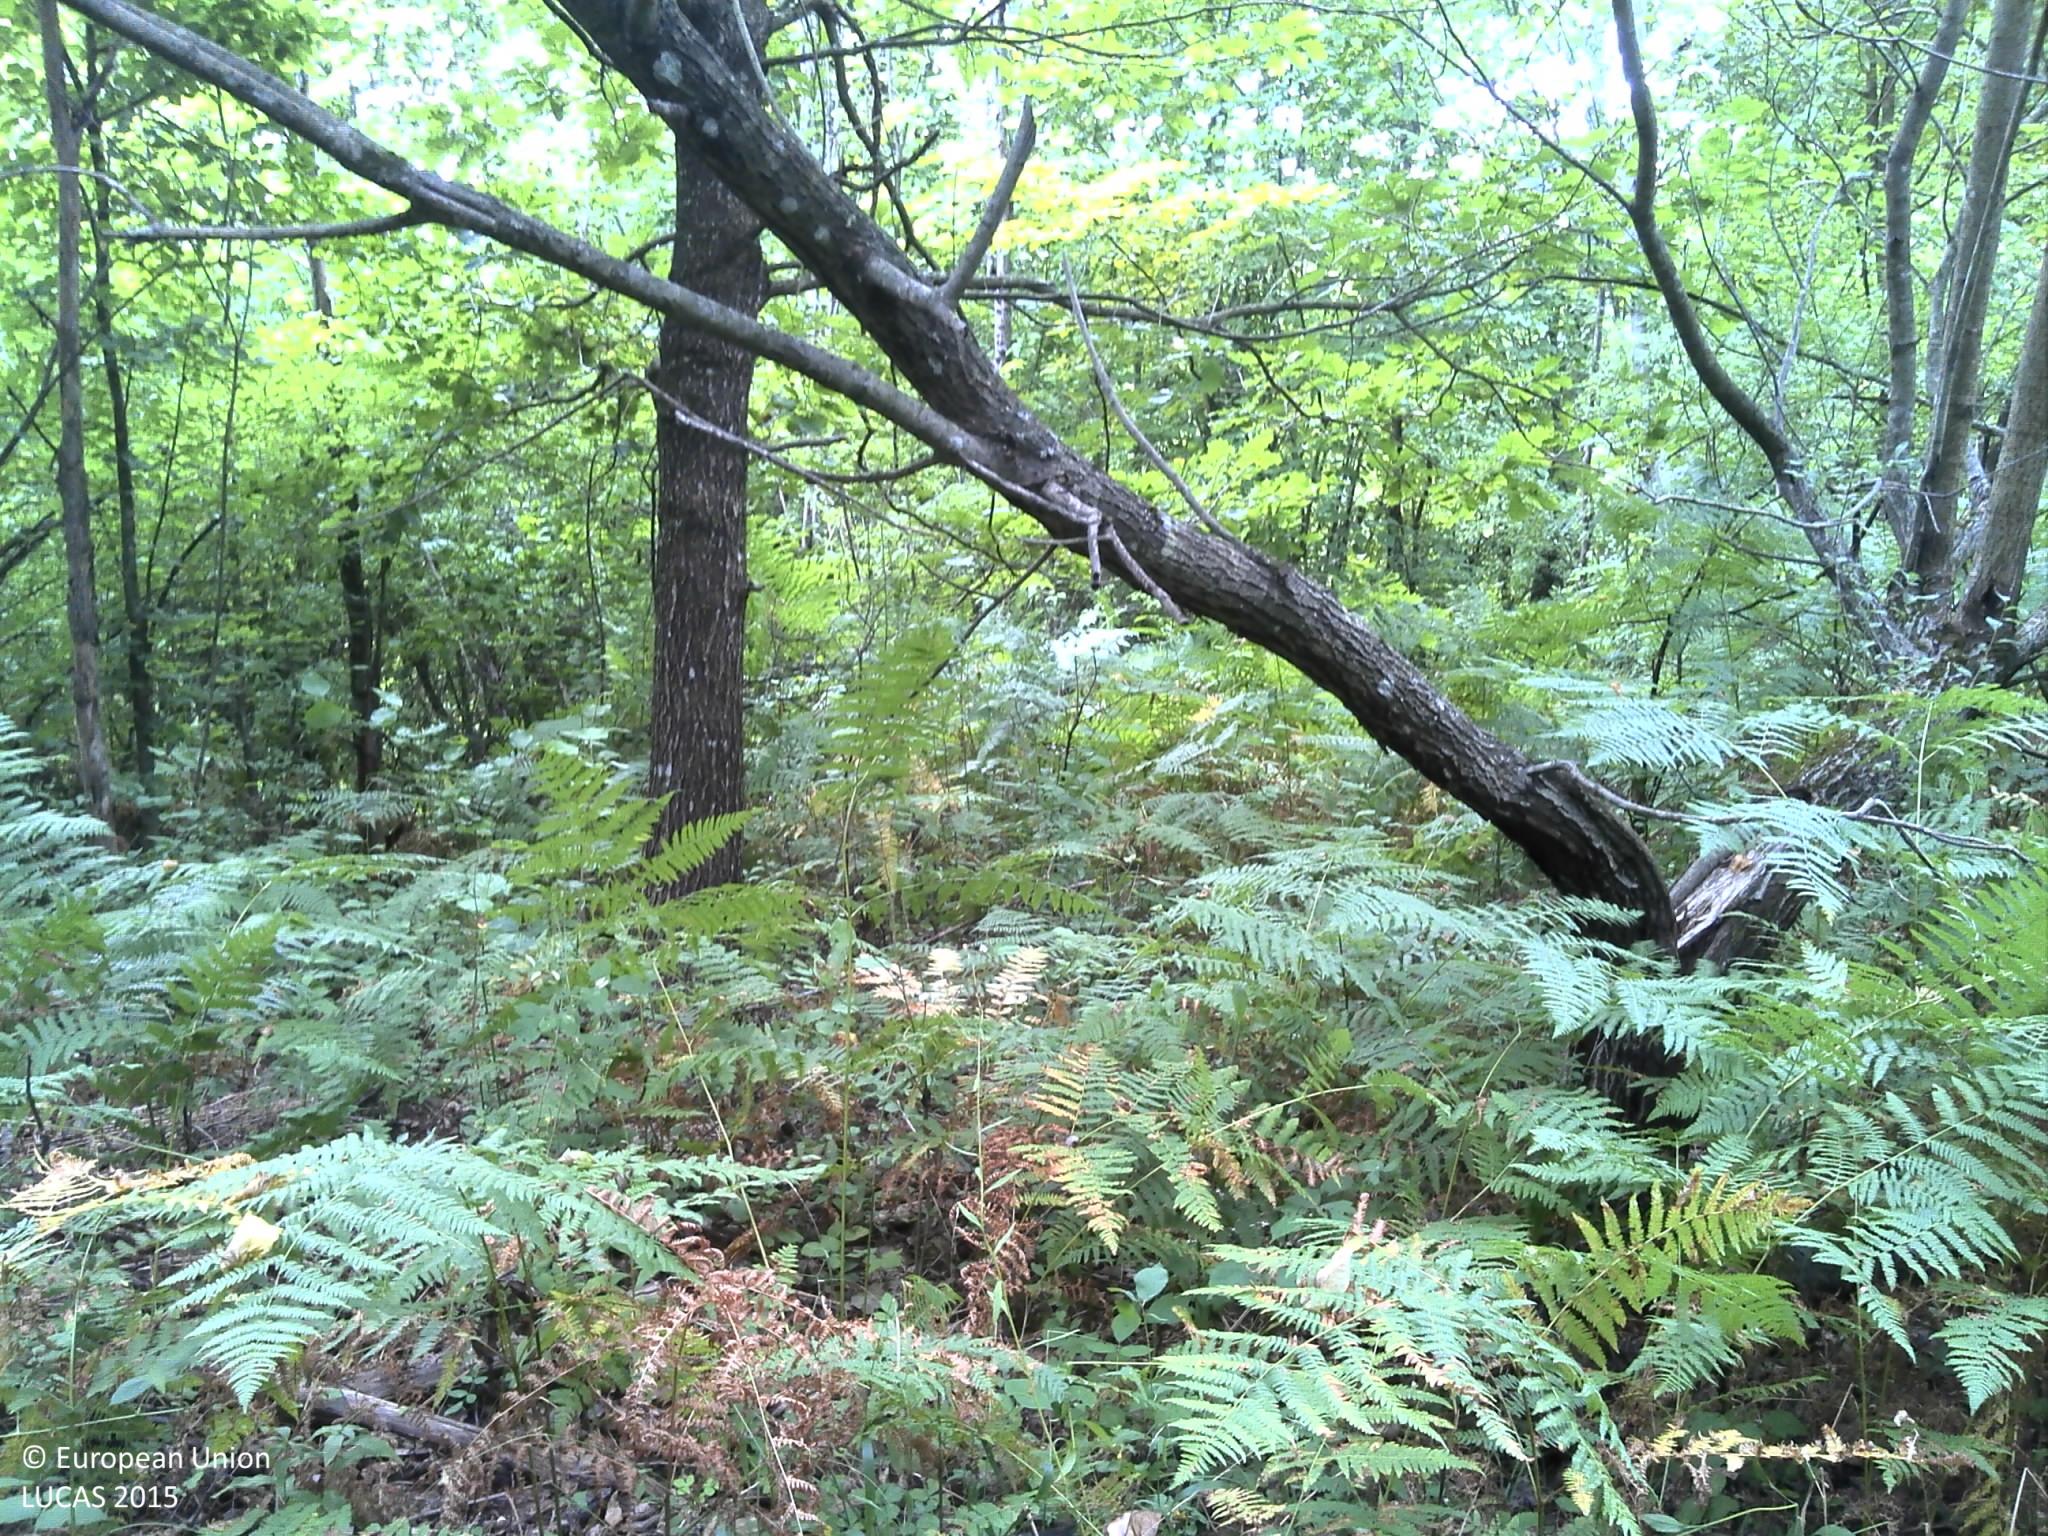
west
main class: Woodland
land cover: Broadleaved woodland
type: beech forest
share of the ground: > 75 %
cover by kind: broadleaved forest trees 100 %
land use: Forestry
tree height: > 5 m
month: August
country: HR
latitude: 45.2722
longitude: 16.1276
